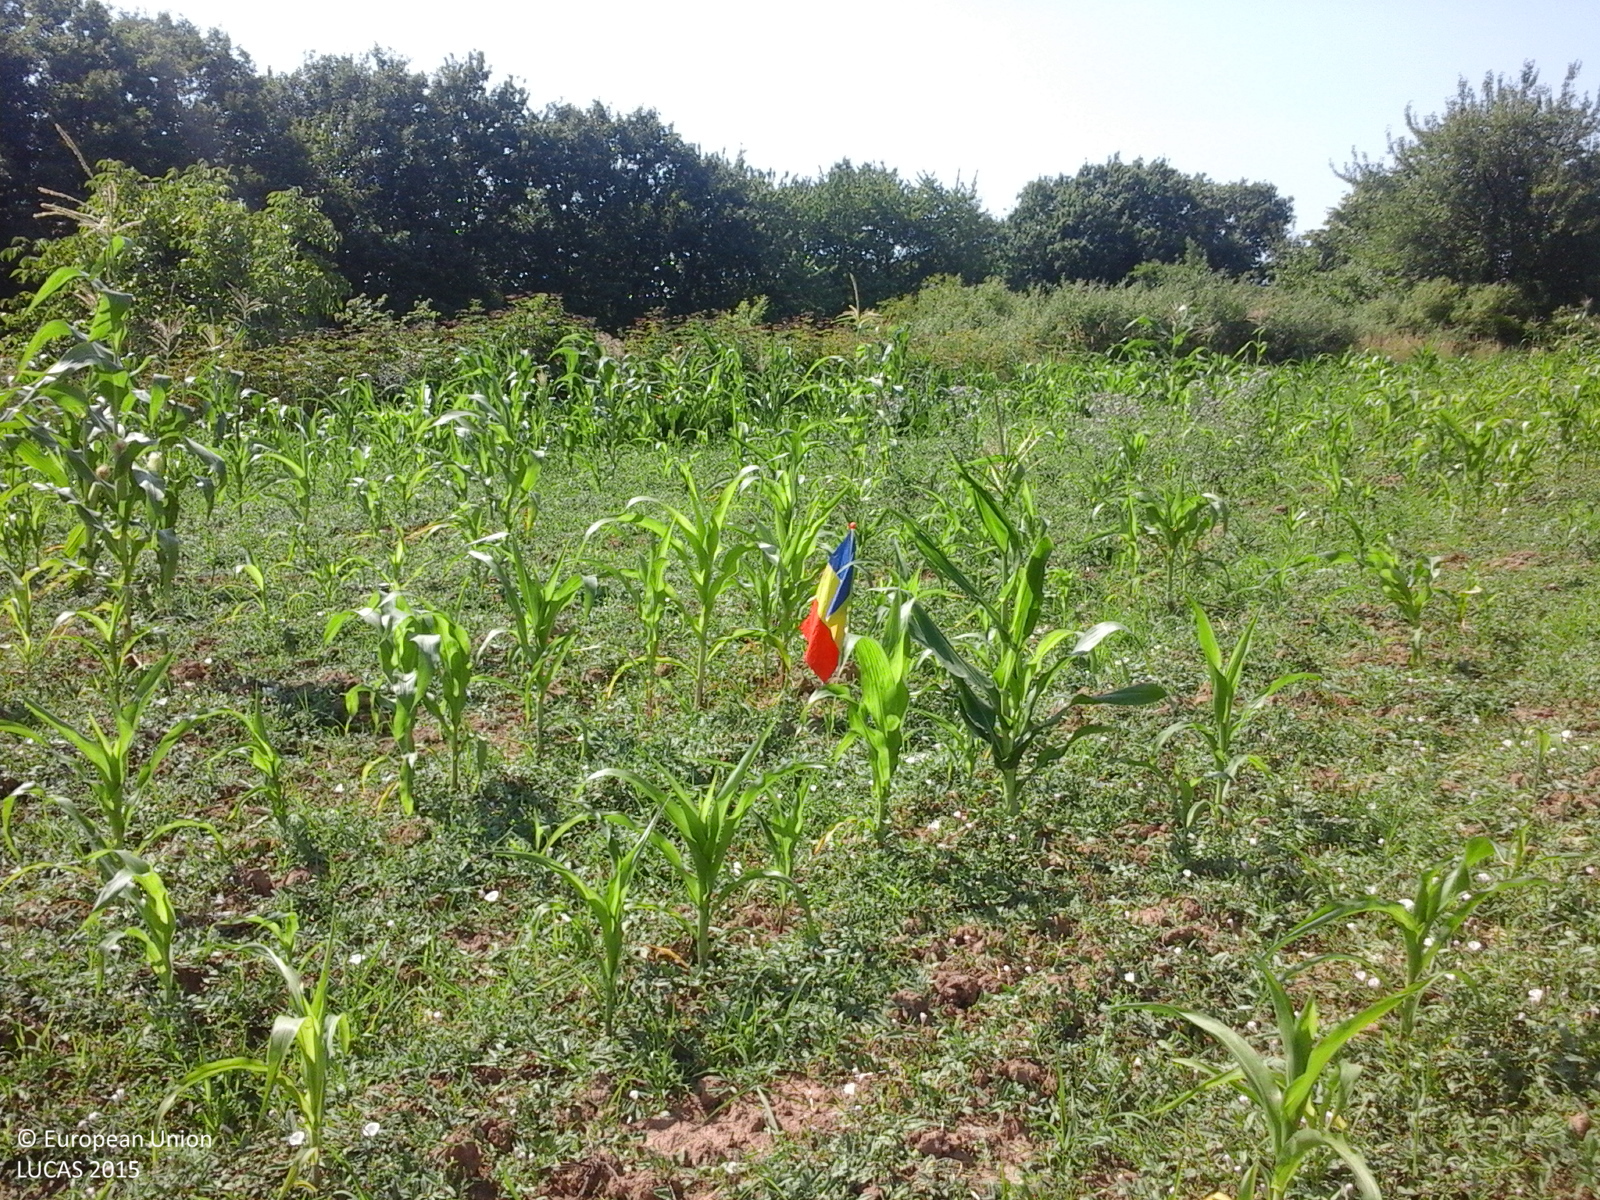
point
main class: Cropland
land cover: Maize
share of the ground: 25 - 50 %
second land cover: Spontaneously vegetated surfaces
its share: > 75 %
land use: Agriculture (excluding fallow land and kitchen gardens)
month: August
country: RO
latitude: 46.2649
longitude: 26.9998
